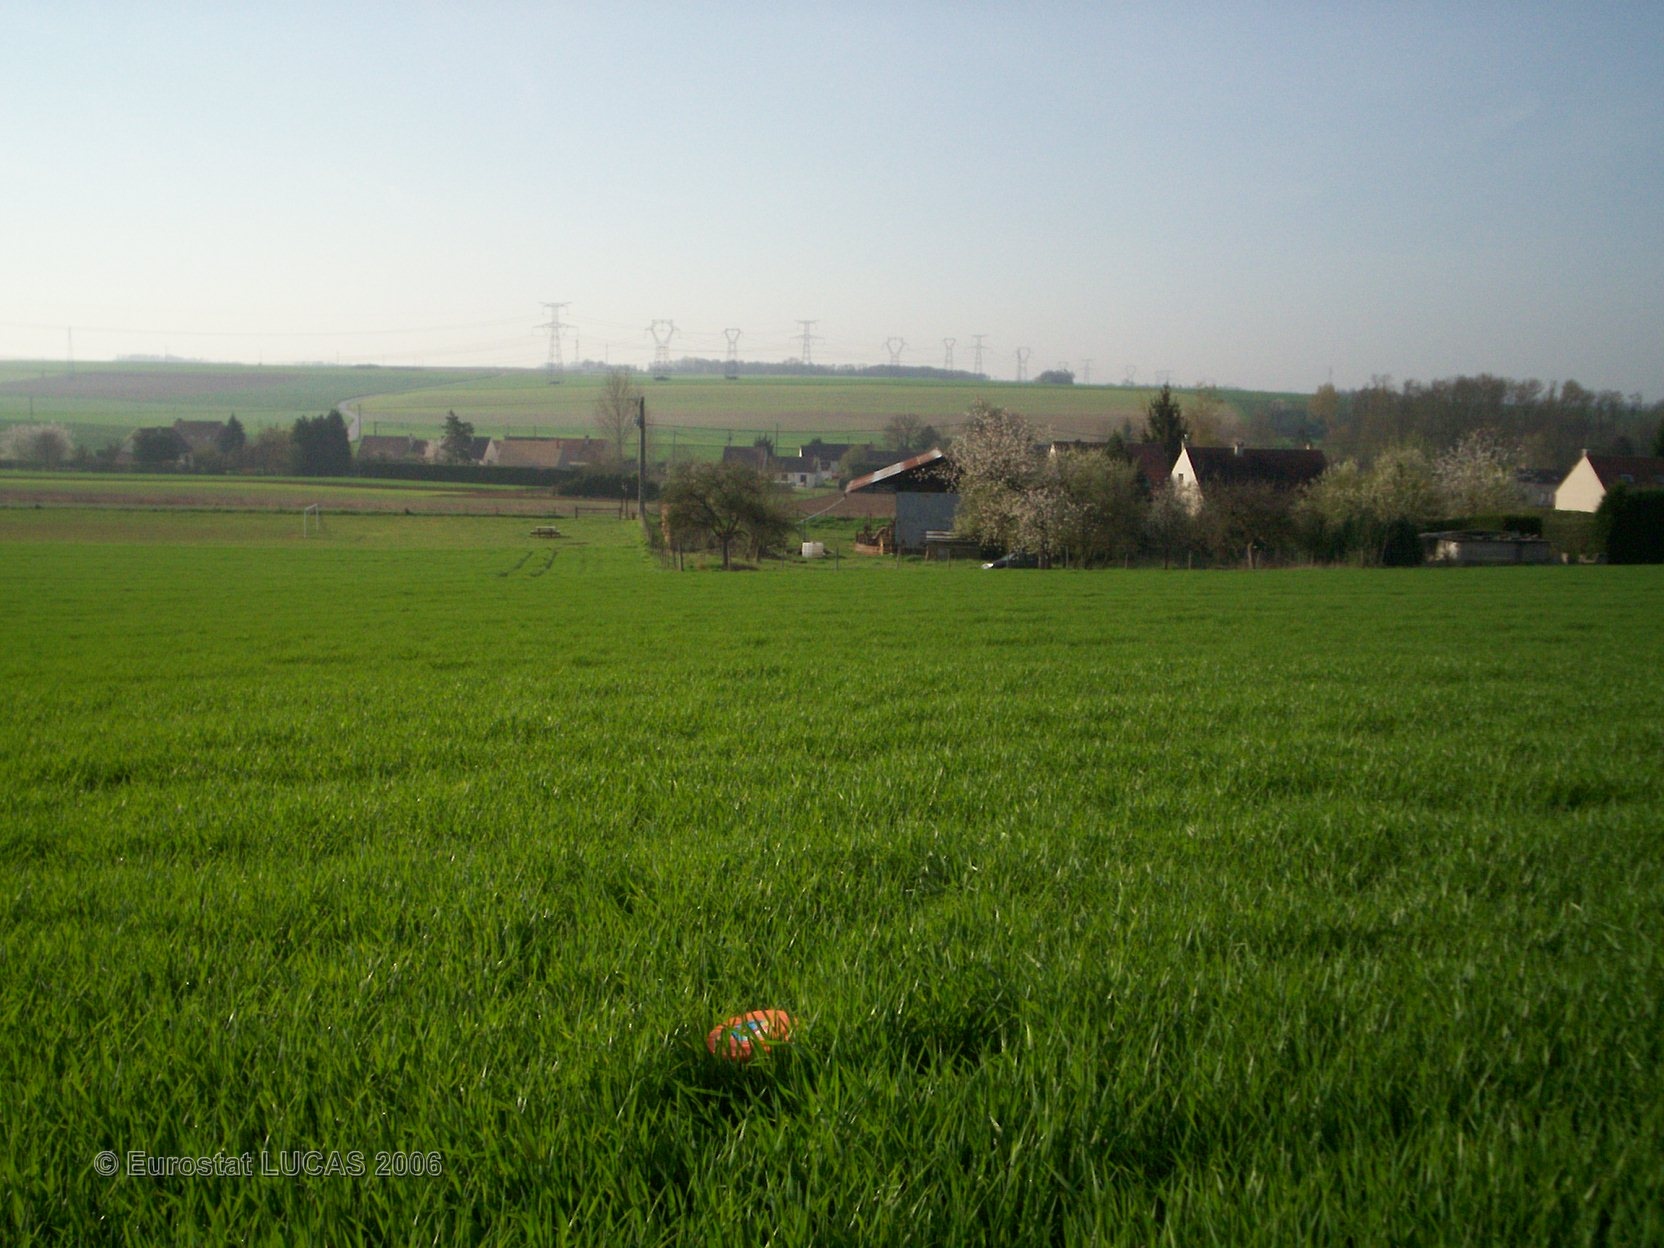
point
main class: Cropland
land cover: Barley
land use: Agriculture (excluding fallow land and kitchen gardens)
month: April
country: FR
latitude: 48.3527
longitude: 2.8528
